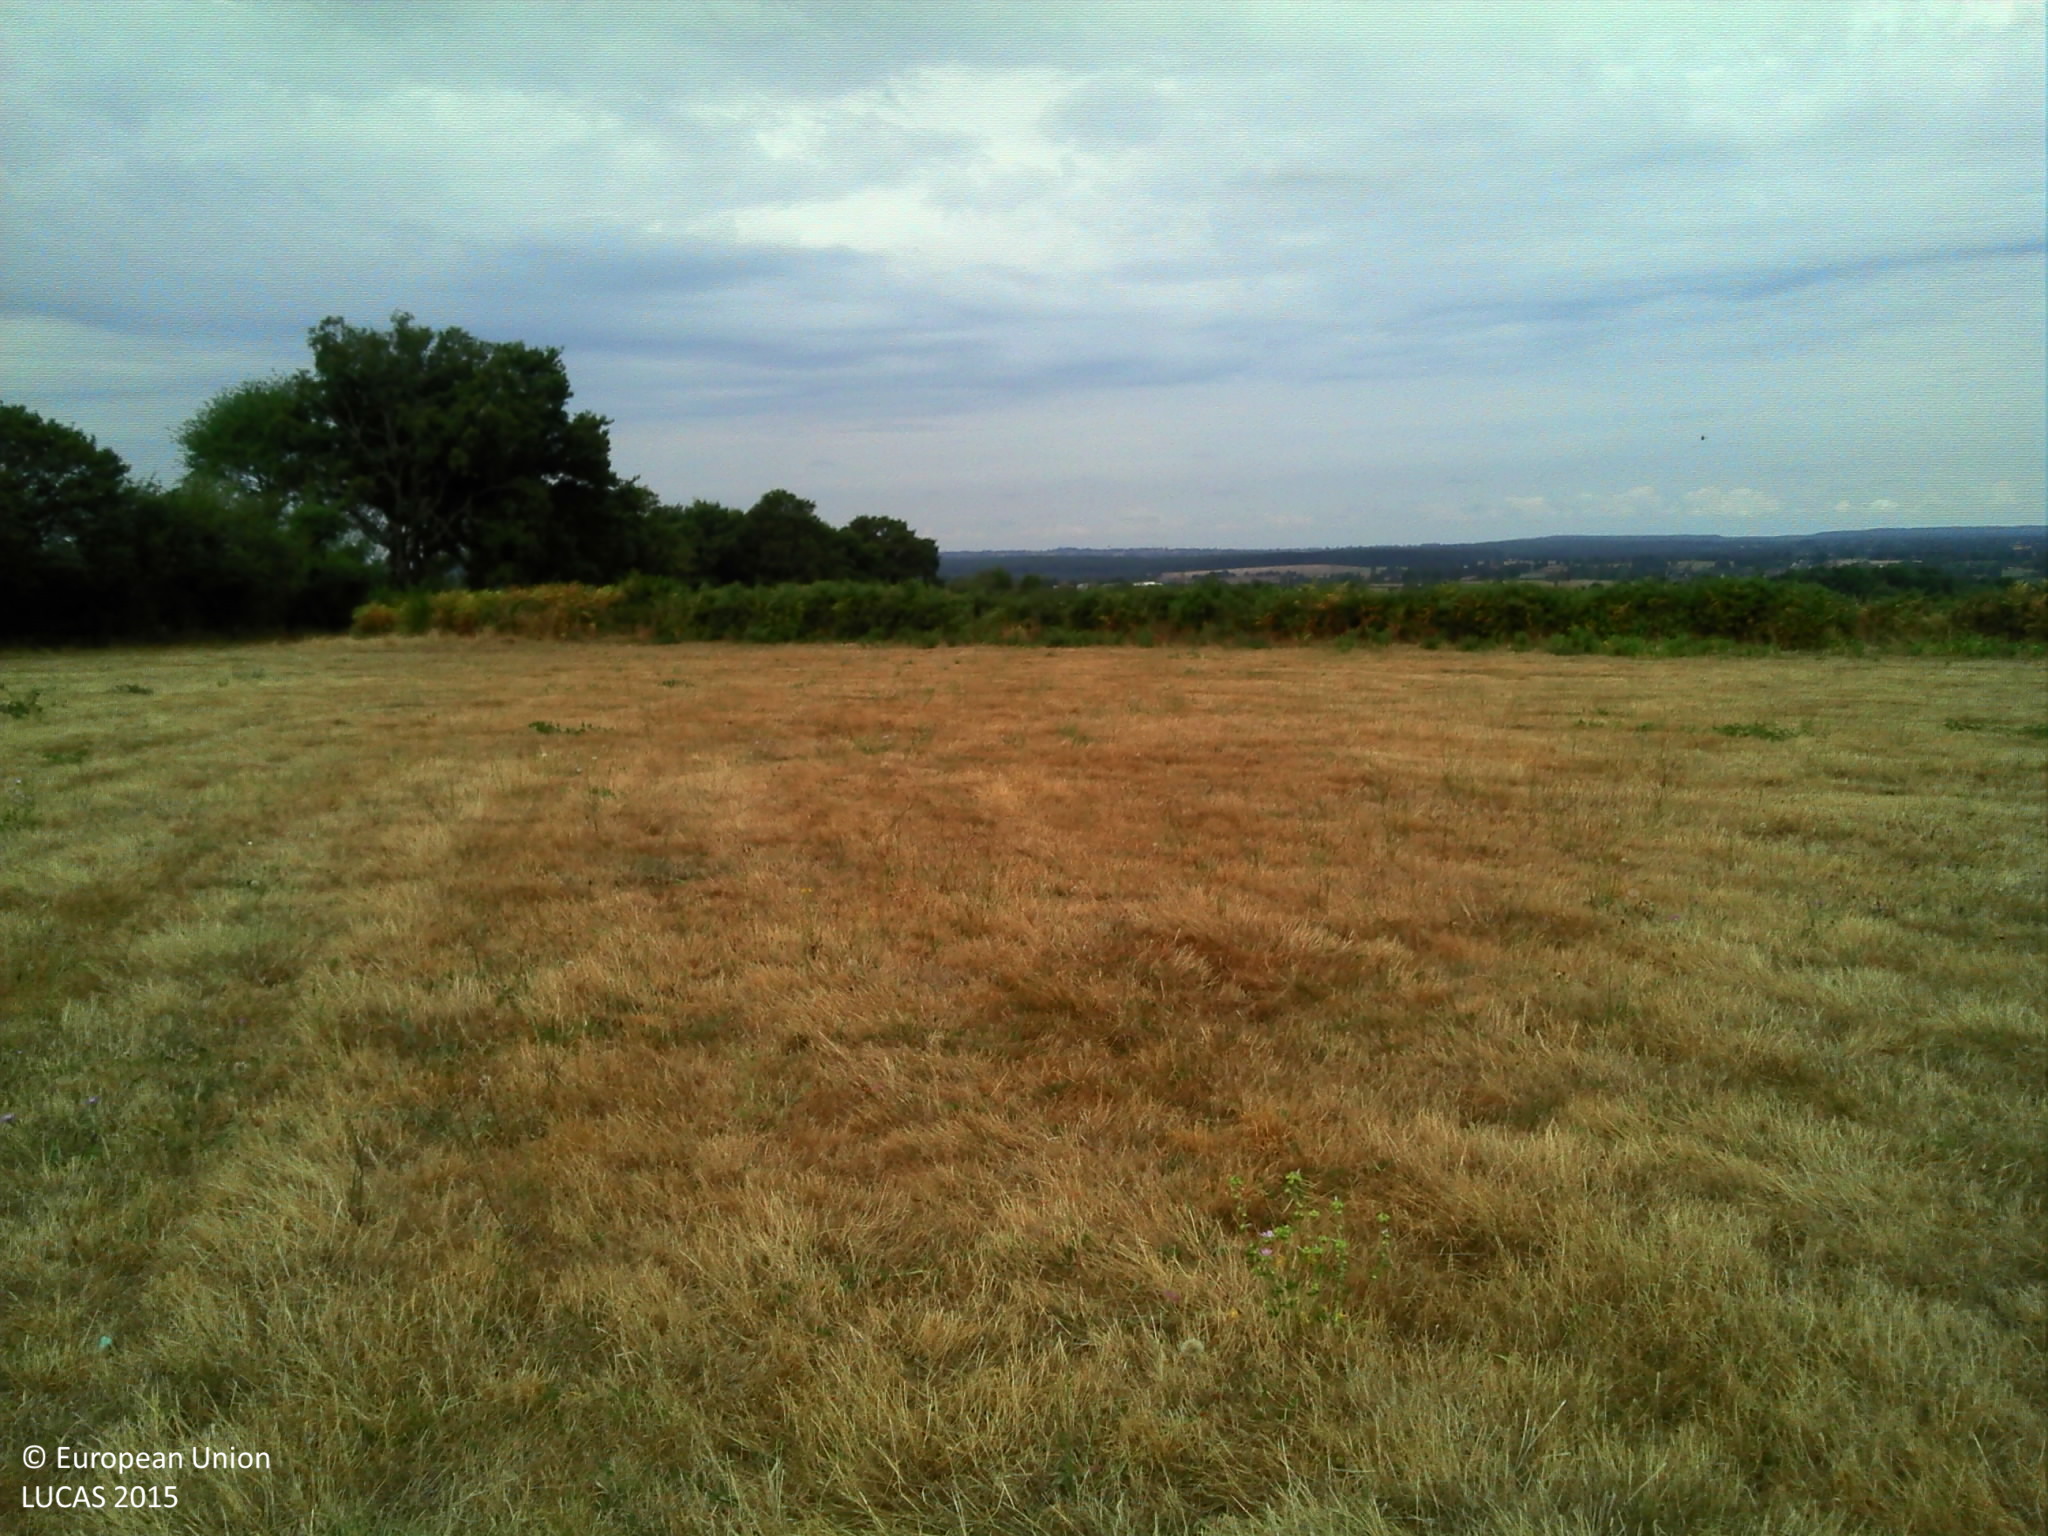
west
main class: Grassland
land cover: Grassland without tree/shrub cover
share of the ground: > 75 %
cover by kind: herbaceous plants 100 %
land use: Agriculture (excluding fallow land and kitchen gardens)
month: July
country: FR
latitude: 46.6105
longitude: 3.0115
